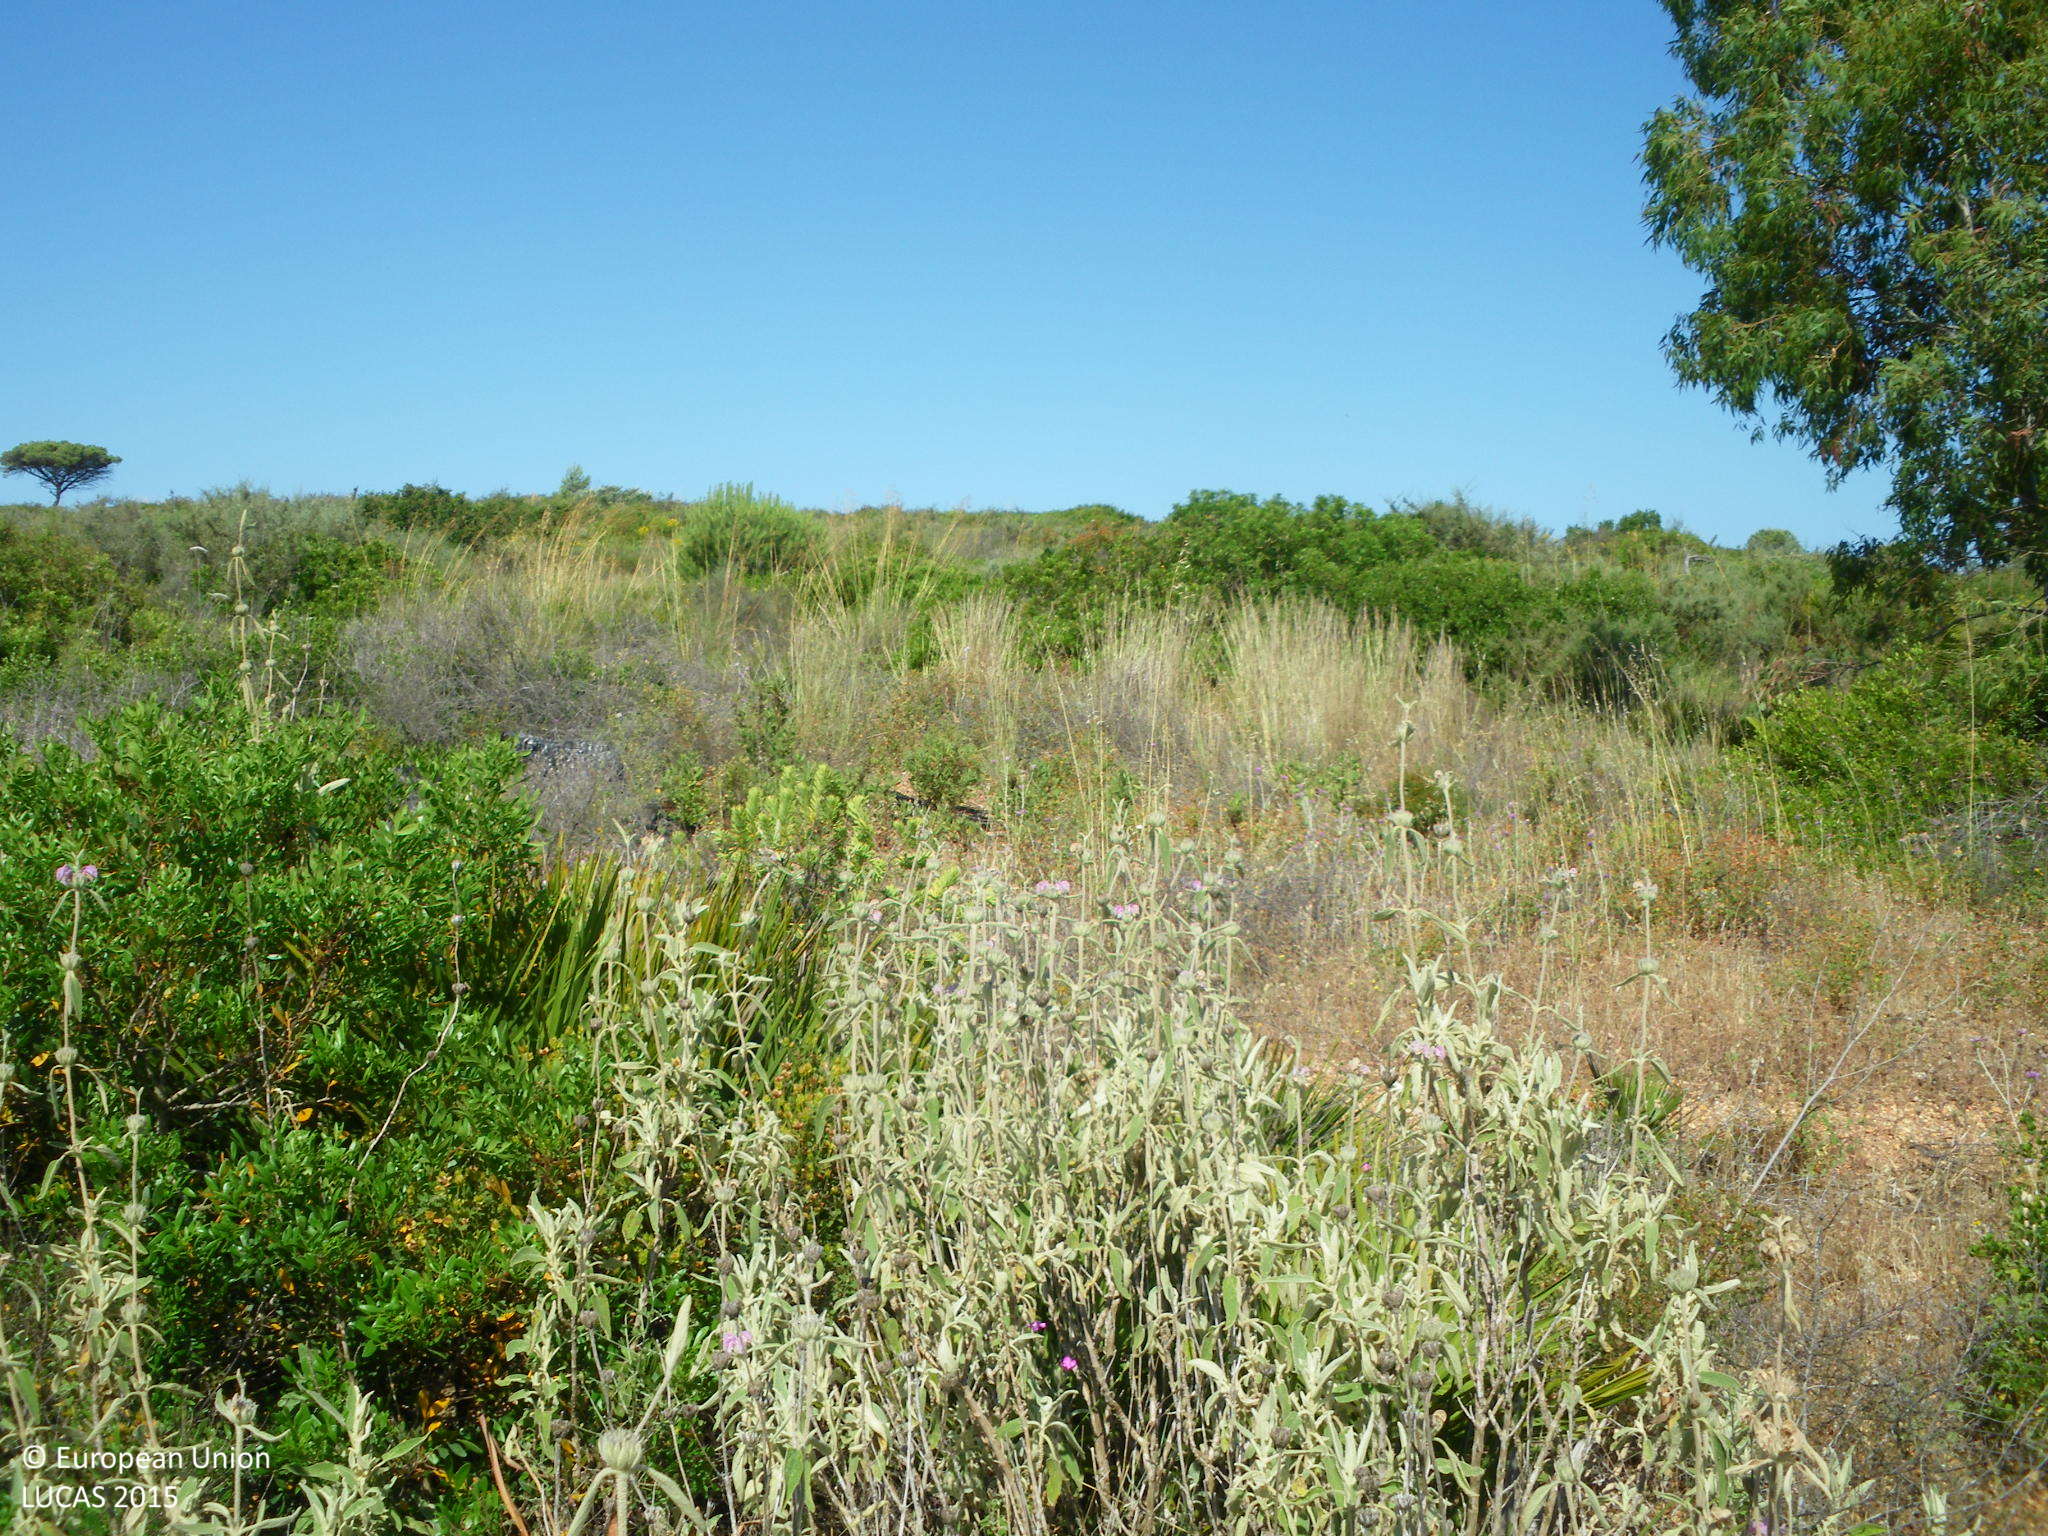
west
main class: Shrubland
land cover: Shrubland with sparse tree cover
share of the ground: > 75 %
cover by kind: shrubs 80 %, herbaceous plants 15 %, broadleaved forest trees 5 %
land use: Semi-natural and natural areas not in use
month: May
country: ES
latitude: 36.3034
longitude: -6.1410
